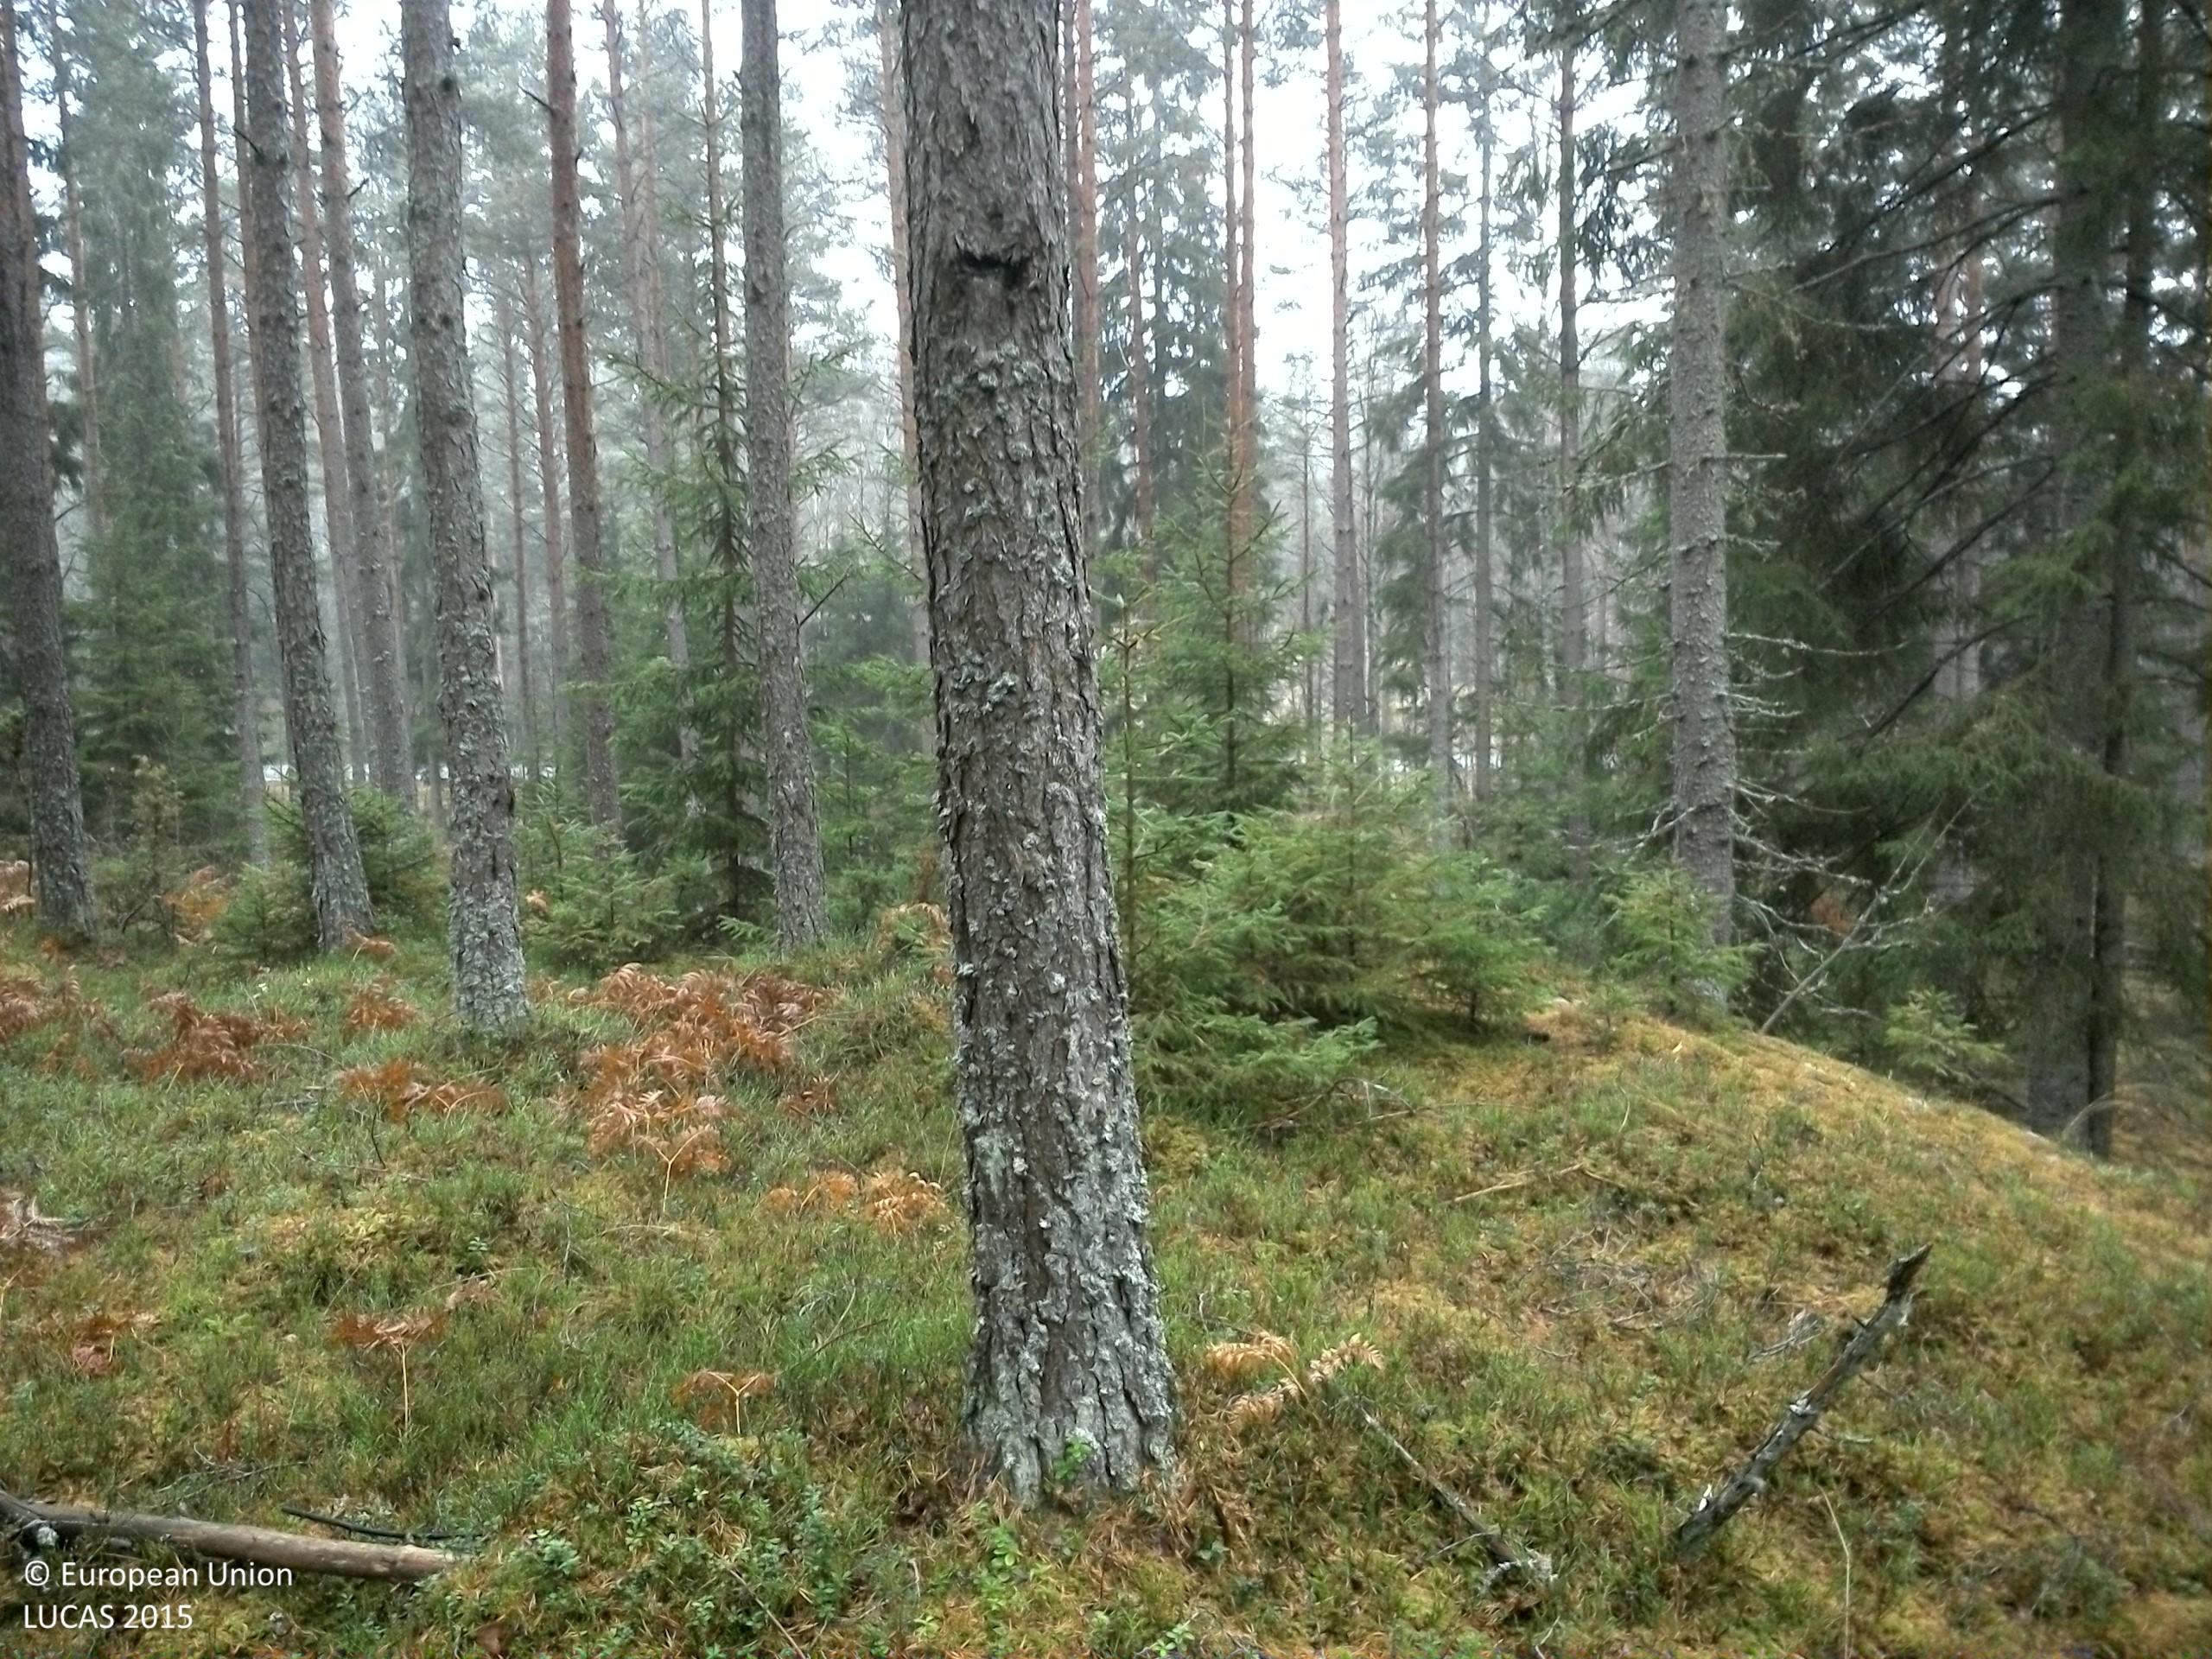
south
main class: Woodland
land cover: Pine dominated coniferous woodland
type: boreal forest
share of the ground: 50 - 75 %
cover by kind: coniferous forest trees 70 %, shrubs 15 %, lichens and mosses 15 %
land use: Forestry
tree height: > 5 m
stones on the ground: < 10 %
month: November
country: SE
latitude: 57.6948
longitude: 14.9783
